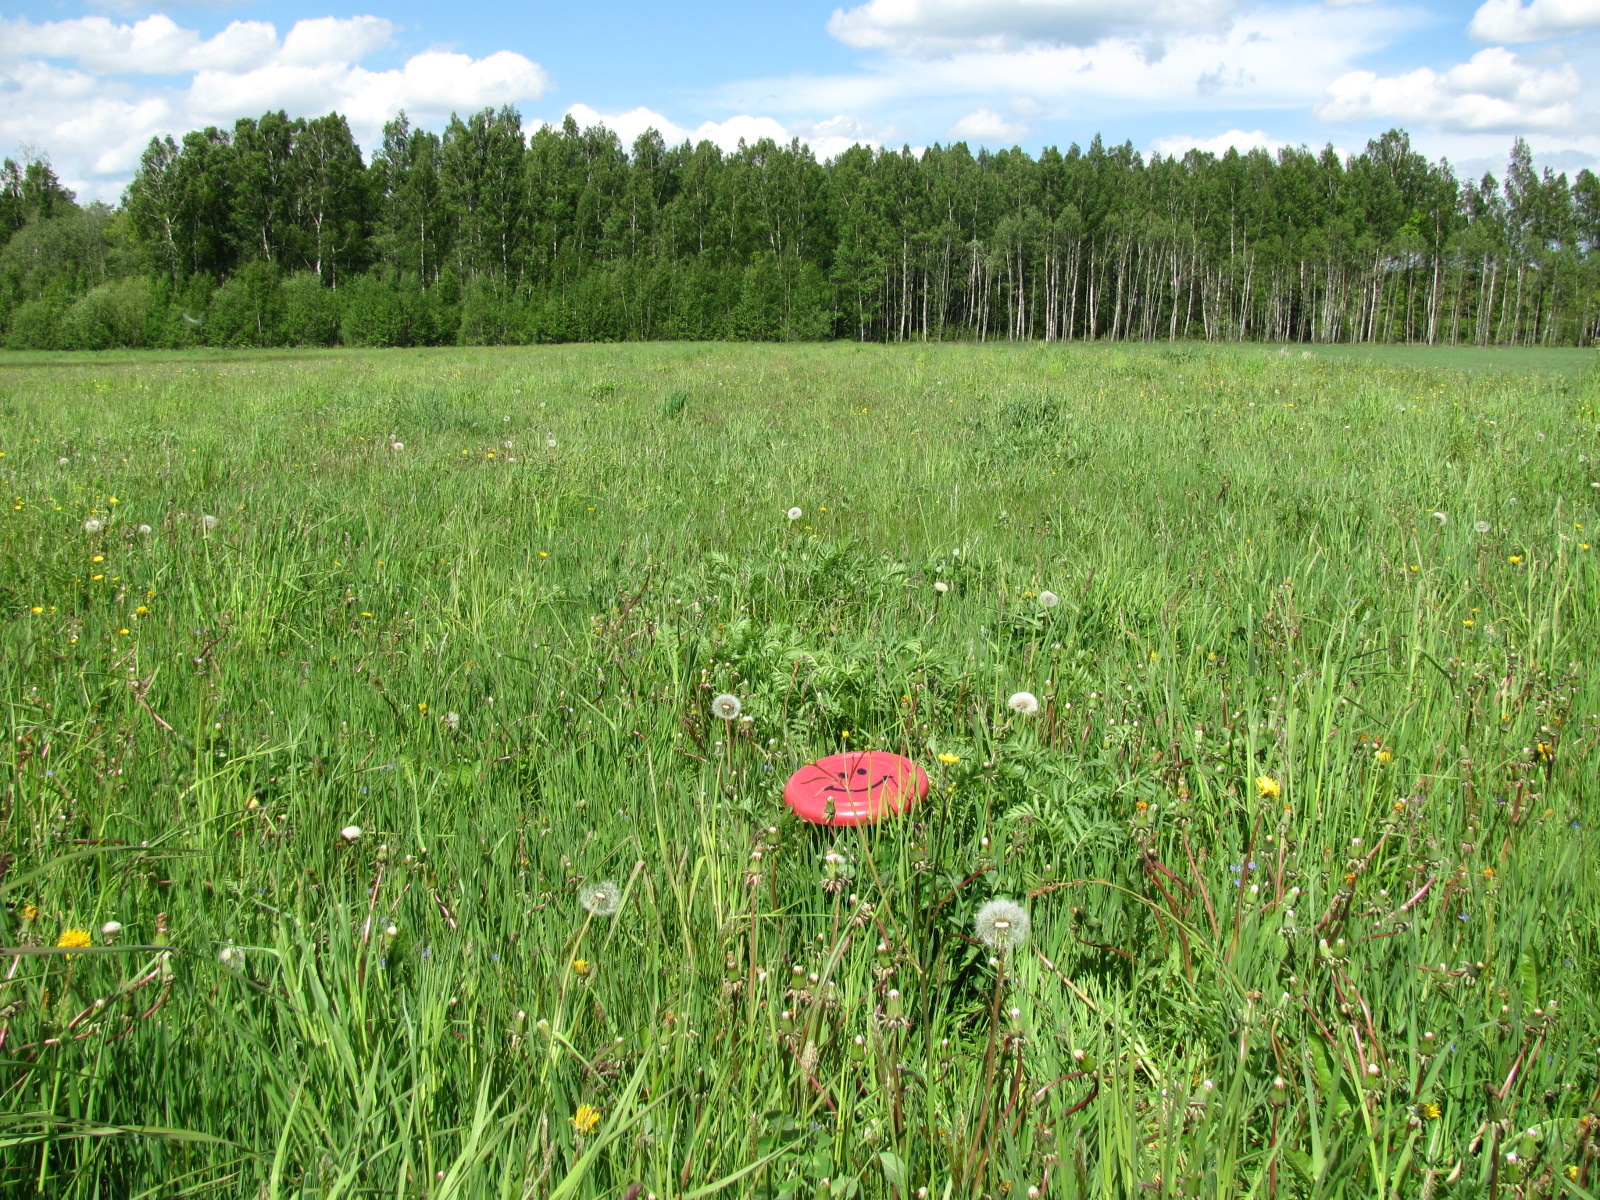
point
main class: Grassland
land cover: Grassland without tree/shrub cover
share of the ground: > 75 %
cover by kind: herbaceous plants 100 %
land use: Agriculture (excluding fallow land and kitchen gardens)
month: May
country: LV
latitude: 56.6267
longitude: 23.9547
